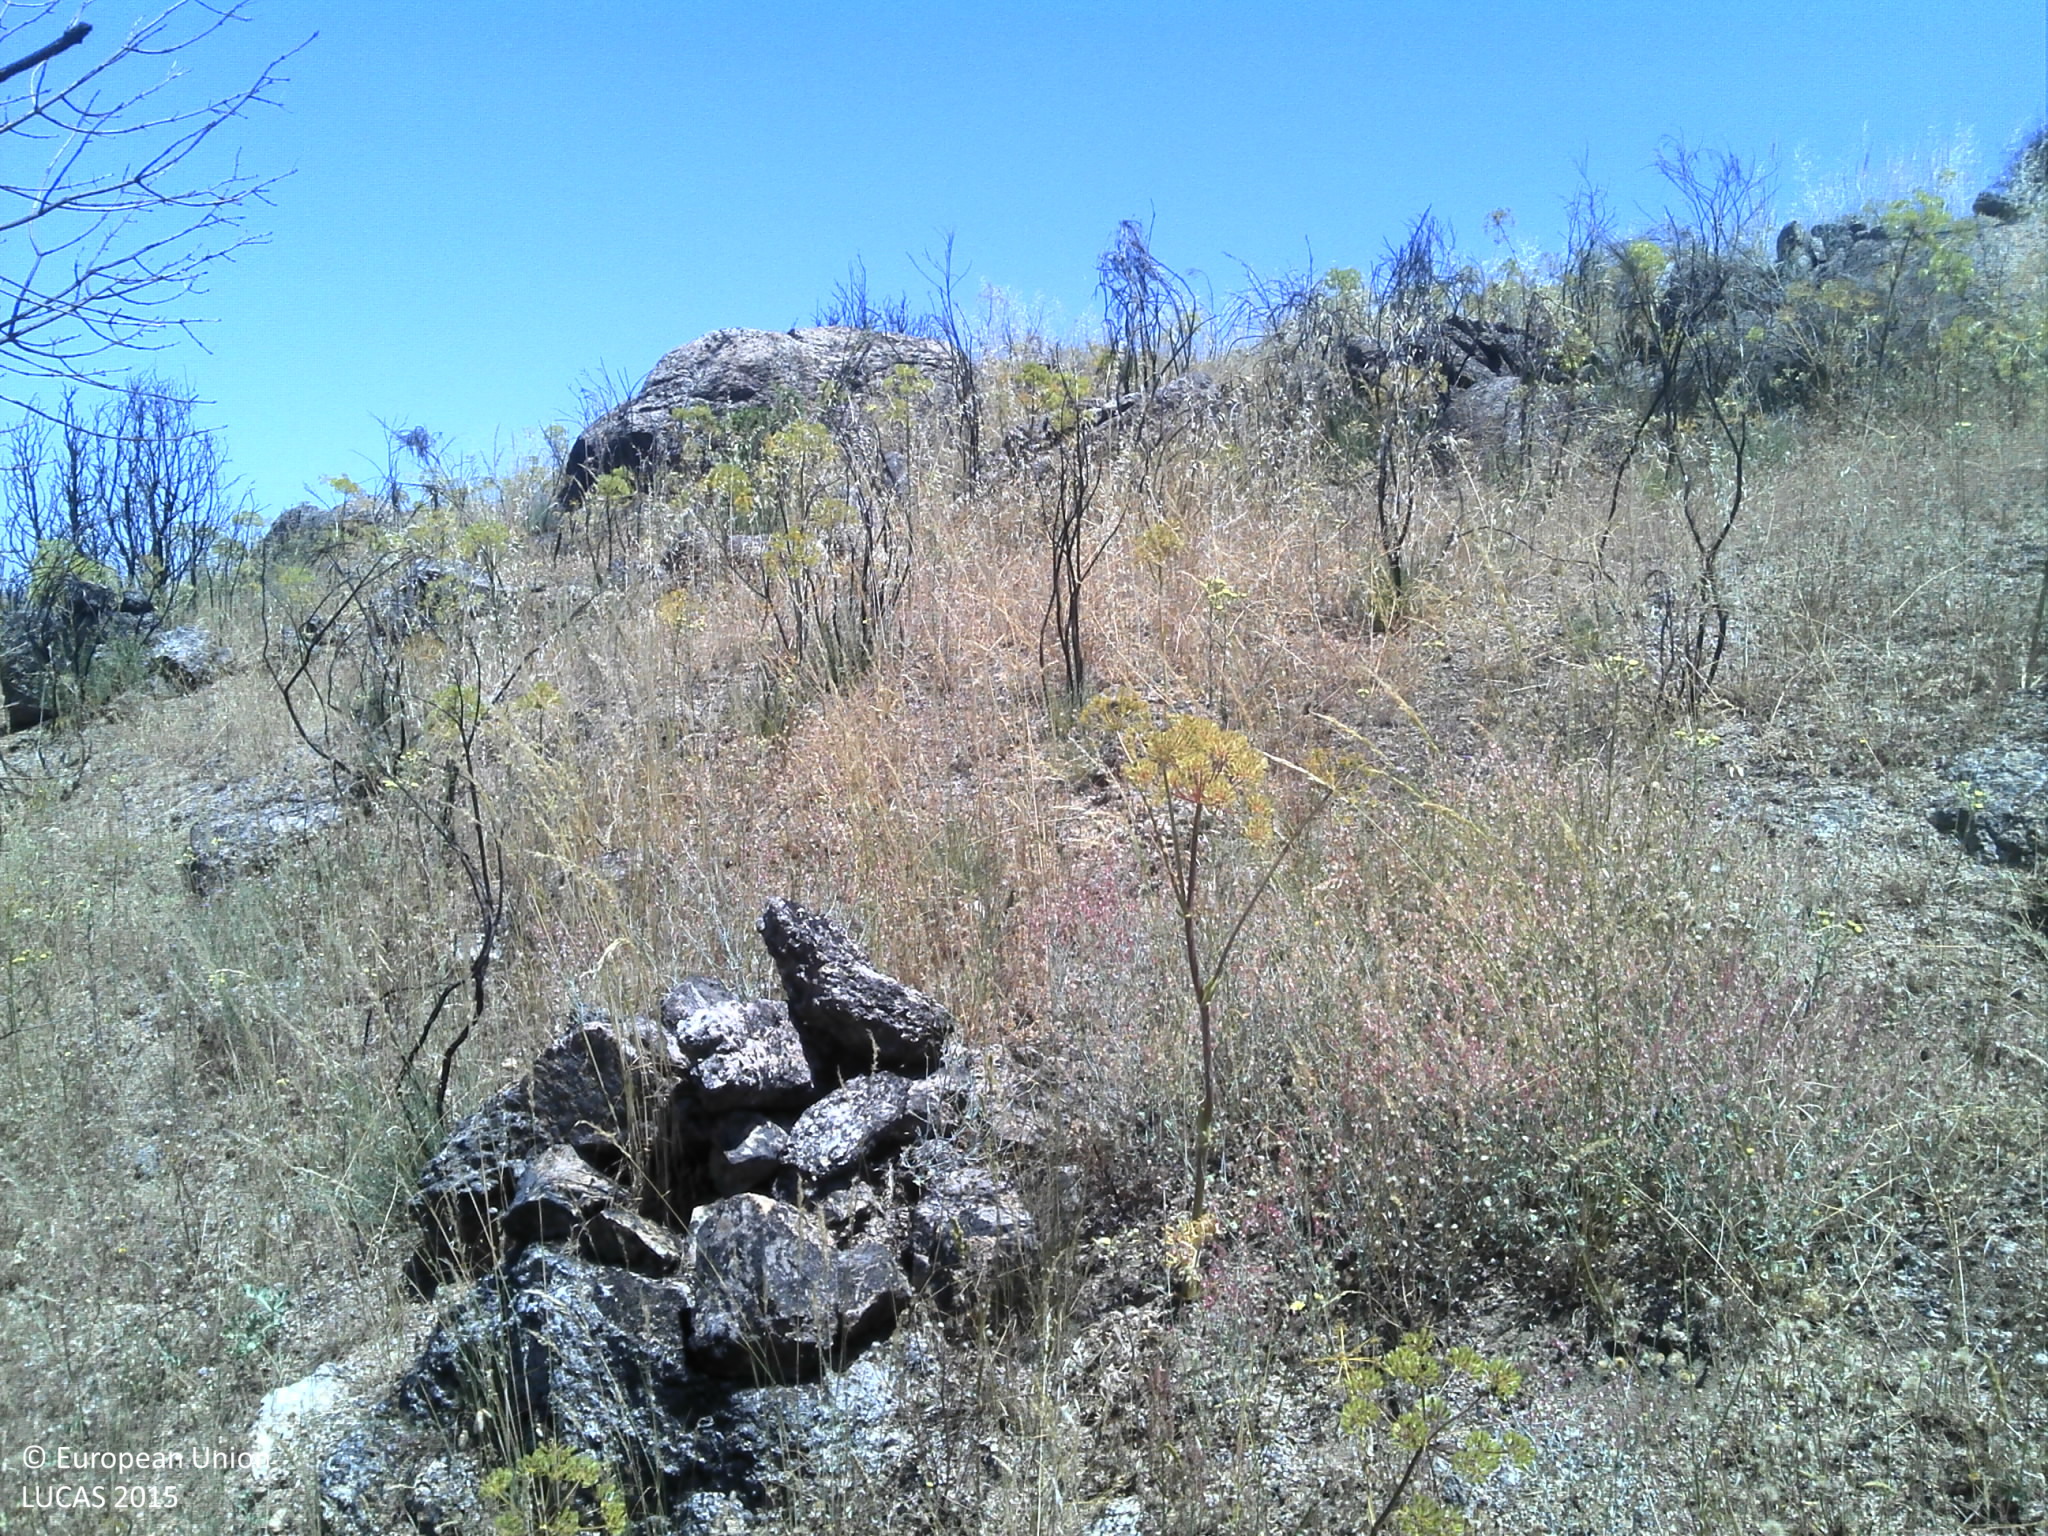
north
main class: Grassland
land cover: Grassland with sparse tree/shrub cover
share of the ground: 50 - 75 %
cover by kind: herbaceous plants 60 %, unconsolidated bare surface 30 %, broadleaved forest trees 5 %, shrubs 5 %
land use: Semi-natural and natural areas not in use
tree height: < 5 m
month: June
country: PT
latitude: 40.6813
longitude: -6.9368
